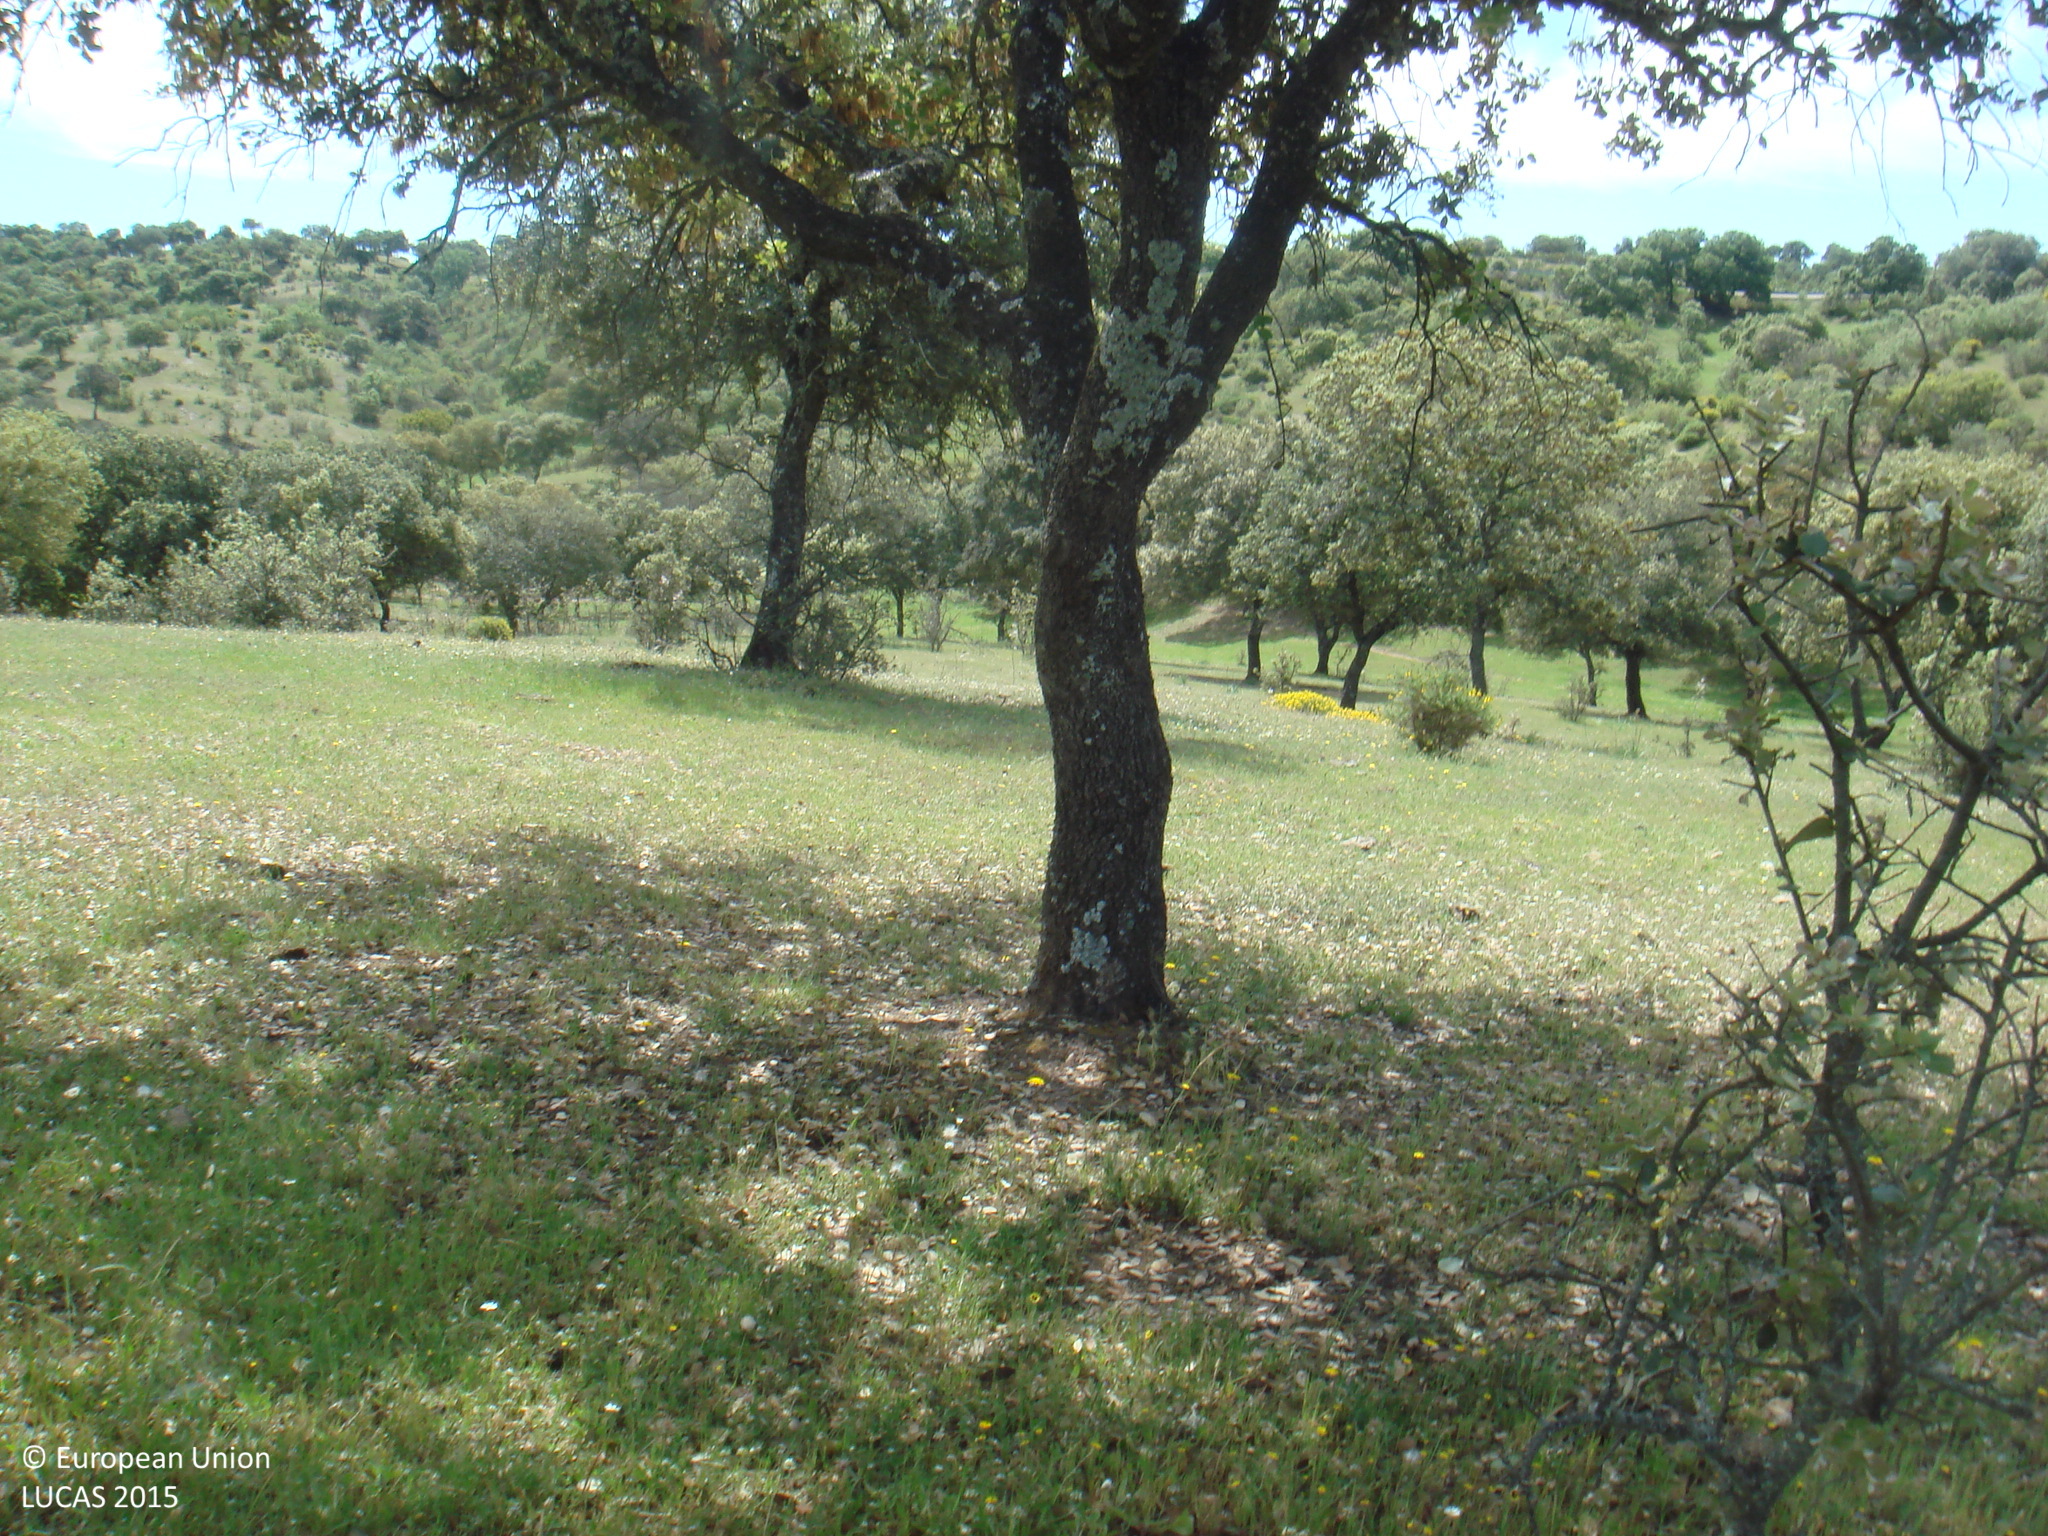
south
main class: Woodland
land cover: Broadleaved woodland
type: broadleaved evergreen forest
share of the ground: > 75 %
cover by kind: broadleaved forest trees 80 %, coniferous forest trees 20 %
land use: Forestry
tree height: > 5 m
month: April
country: ES
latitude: 38.1817
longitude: -4.6879
